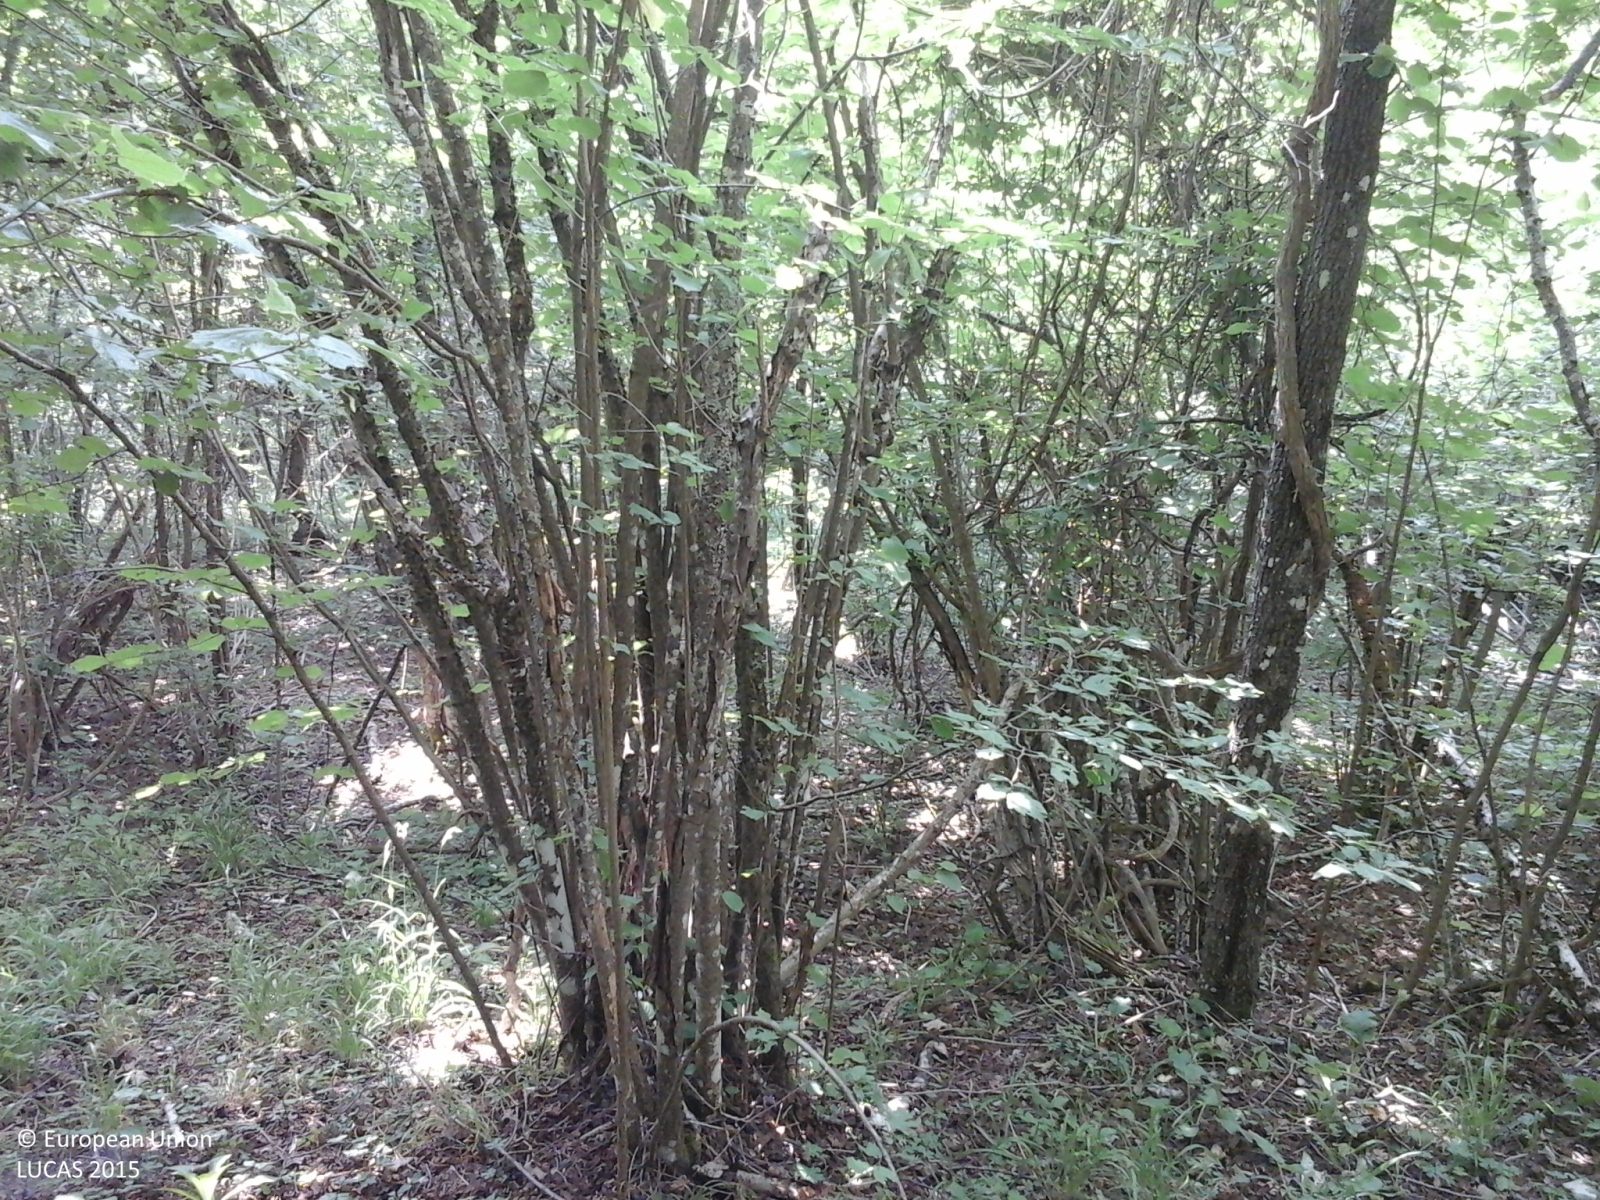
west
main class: Woodland
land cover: Broadleaved woodland
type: mesophytic deciduous forest
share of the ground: > 75 %
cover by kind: broadleaved forest trees 100 %
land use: Forestry
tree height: > 5 m
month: July
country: IT
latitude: 44.7254
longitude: 9.1054
